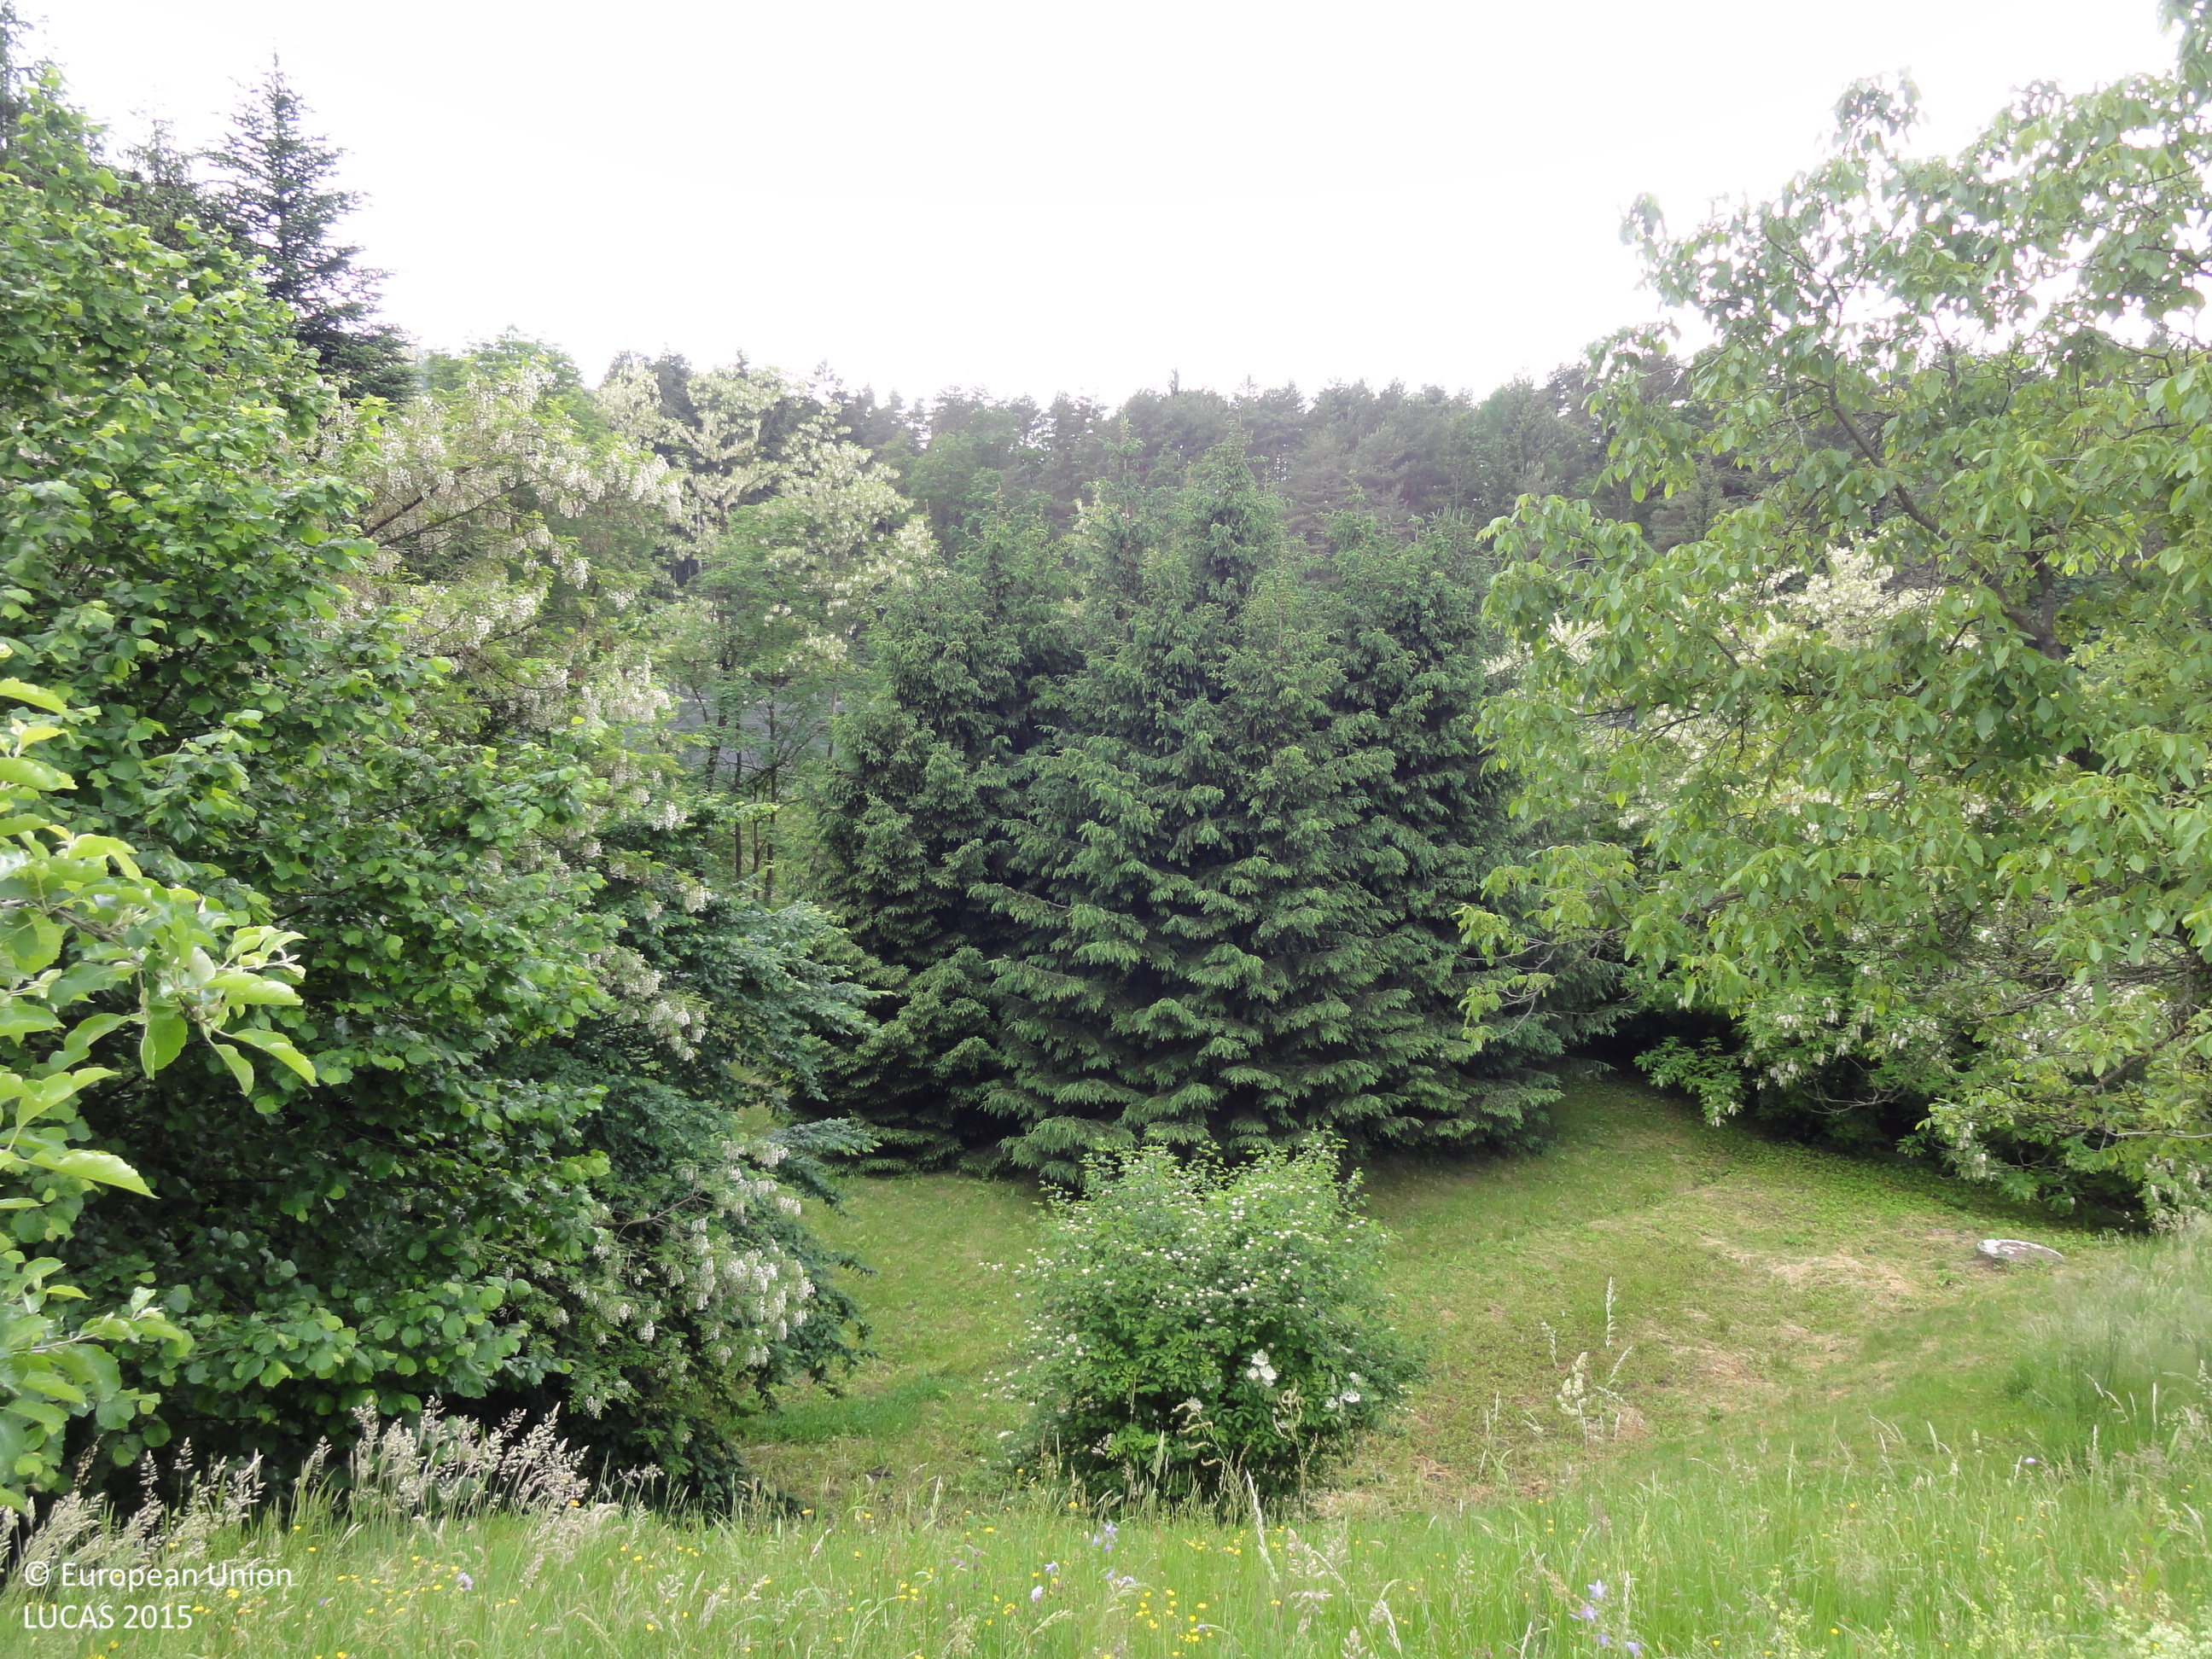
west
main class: Cropland
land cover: Apple fruit
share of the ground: 25 - 50 %
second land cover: Grassland without tree/shrub cover
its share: > 75 %
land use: Agriculture (excluding fallow land and kitchen gardens)
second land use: Residential
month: May
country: SI
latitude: 46.2274
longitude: 15.1449
